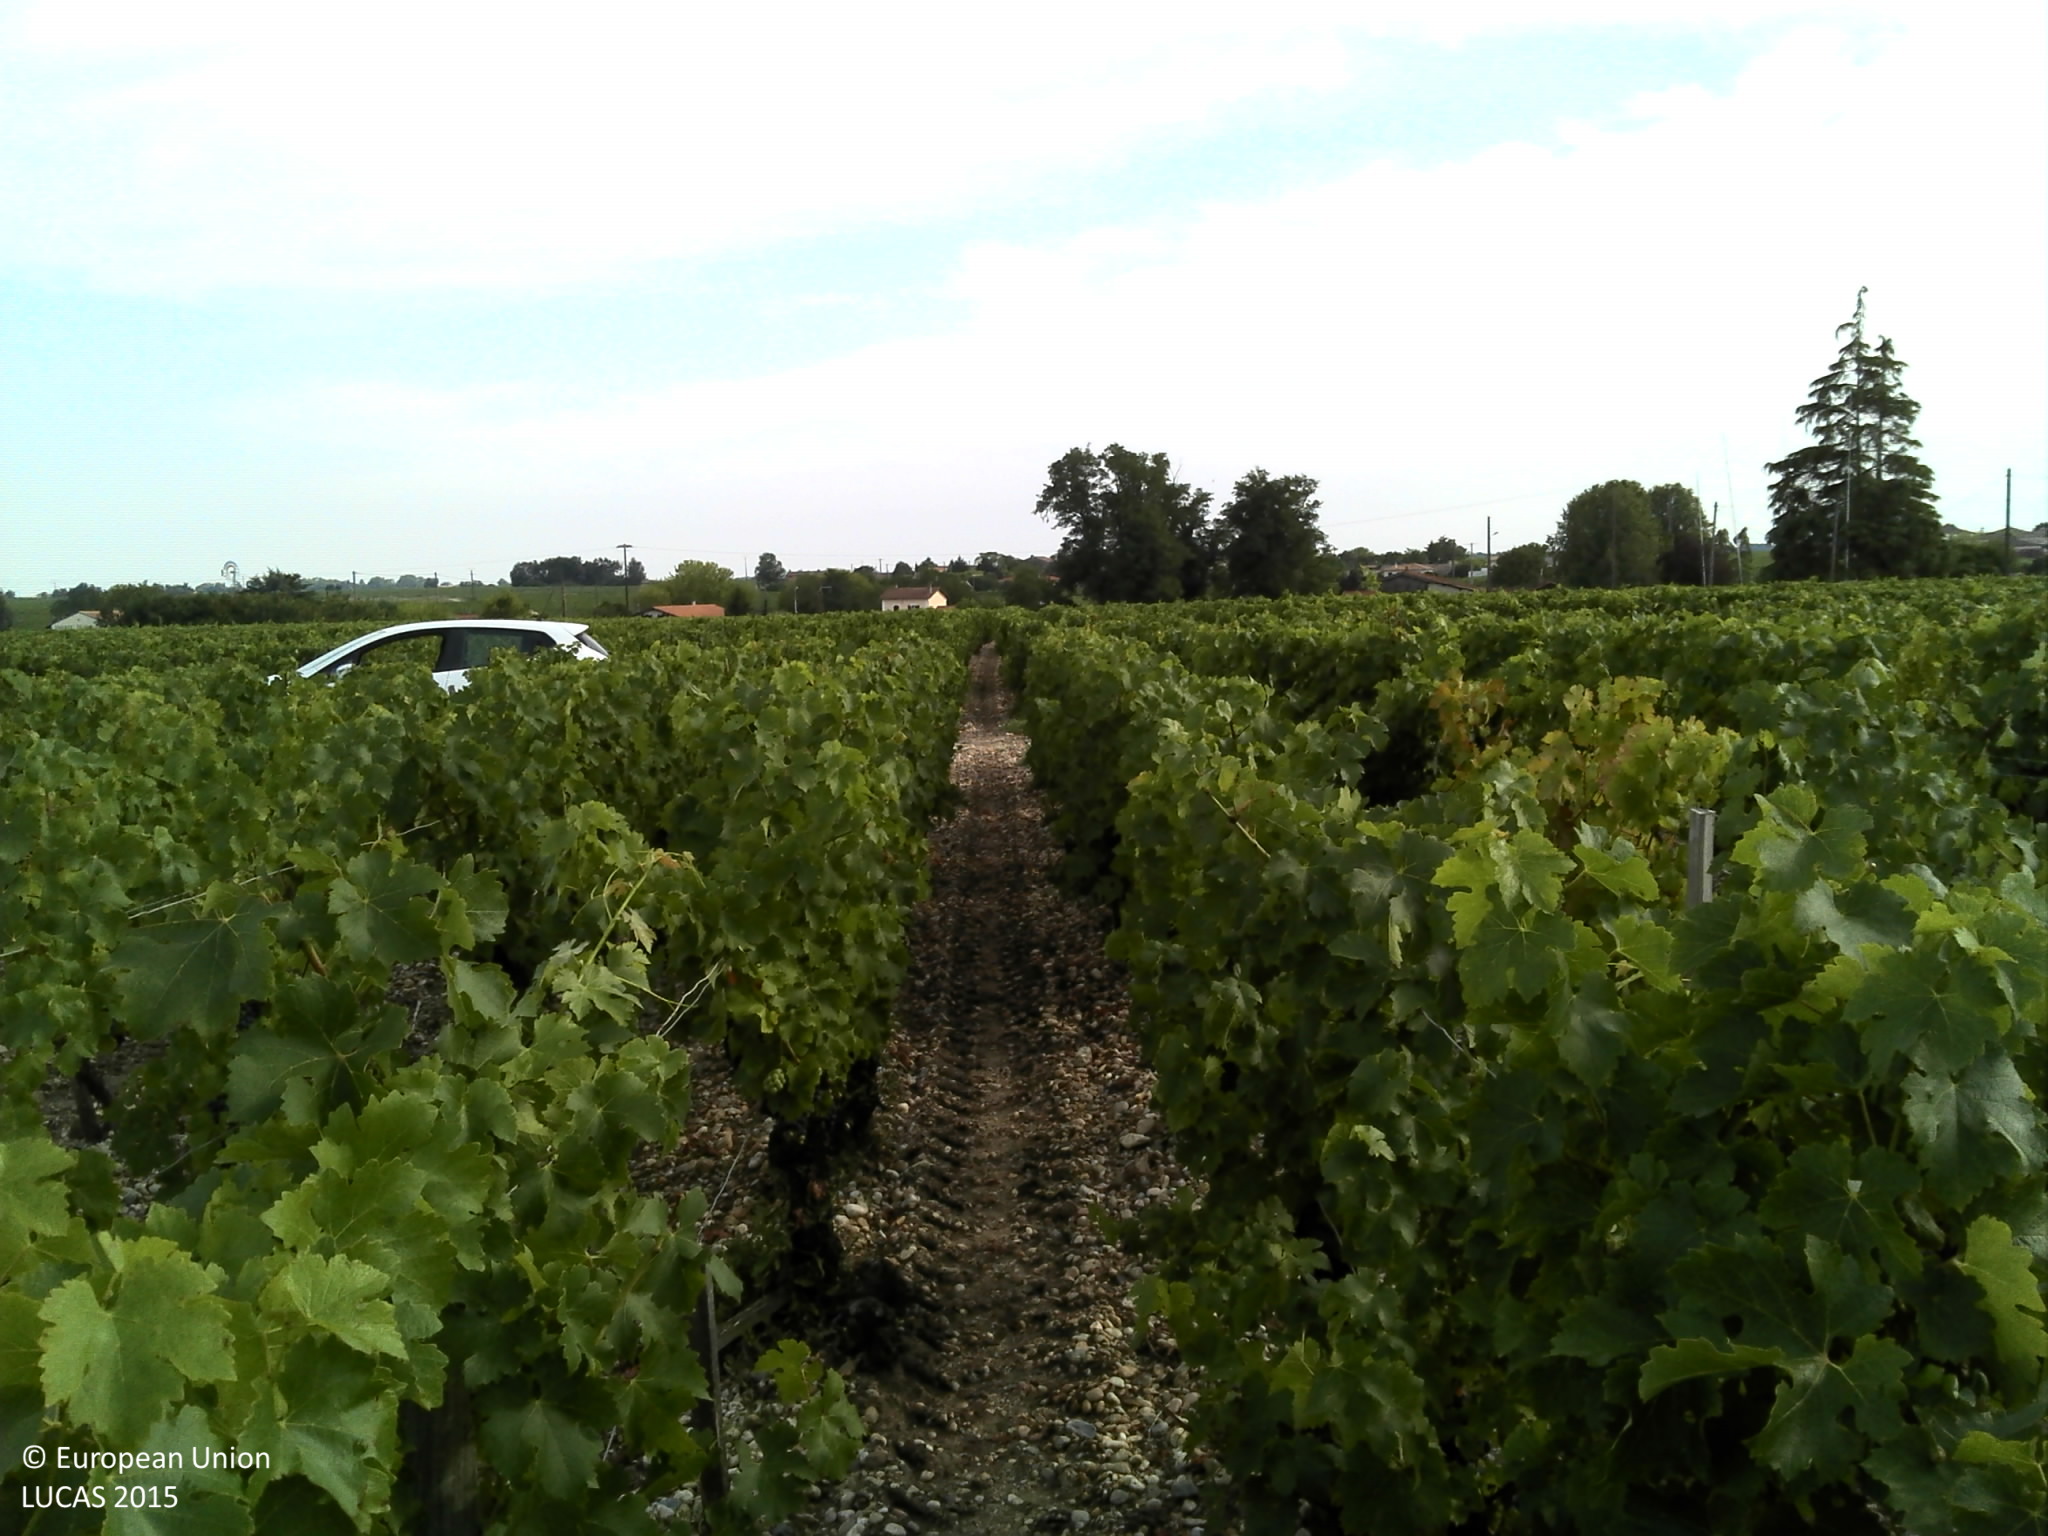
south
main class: Cropland
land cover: Vineyards
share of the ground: 25 - 50 %
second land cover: Other bare soil
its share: > 75 %
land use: Agriculture (excluding fallow land and kitchen gardens)
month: August
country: FR
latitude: 45.2408
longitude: -0.7877
